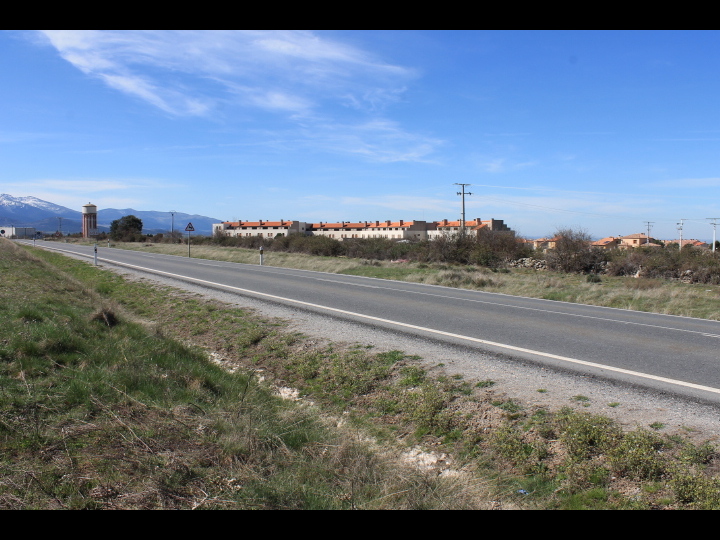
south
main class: Grassland
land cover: Grassland without tree/shrub cover
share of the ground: > 75 %
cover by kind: herbaceous plants 95 %, unconsolidated bare surface 5 %
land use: Agriculture (excluding fallow land and kitchen gardens)
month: April
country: ES
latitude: 40.9575
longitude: -4.0329
